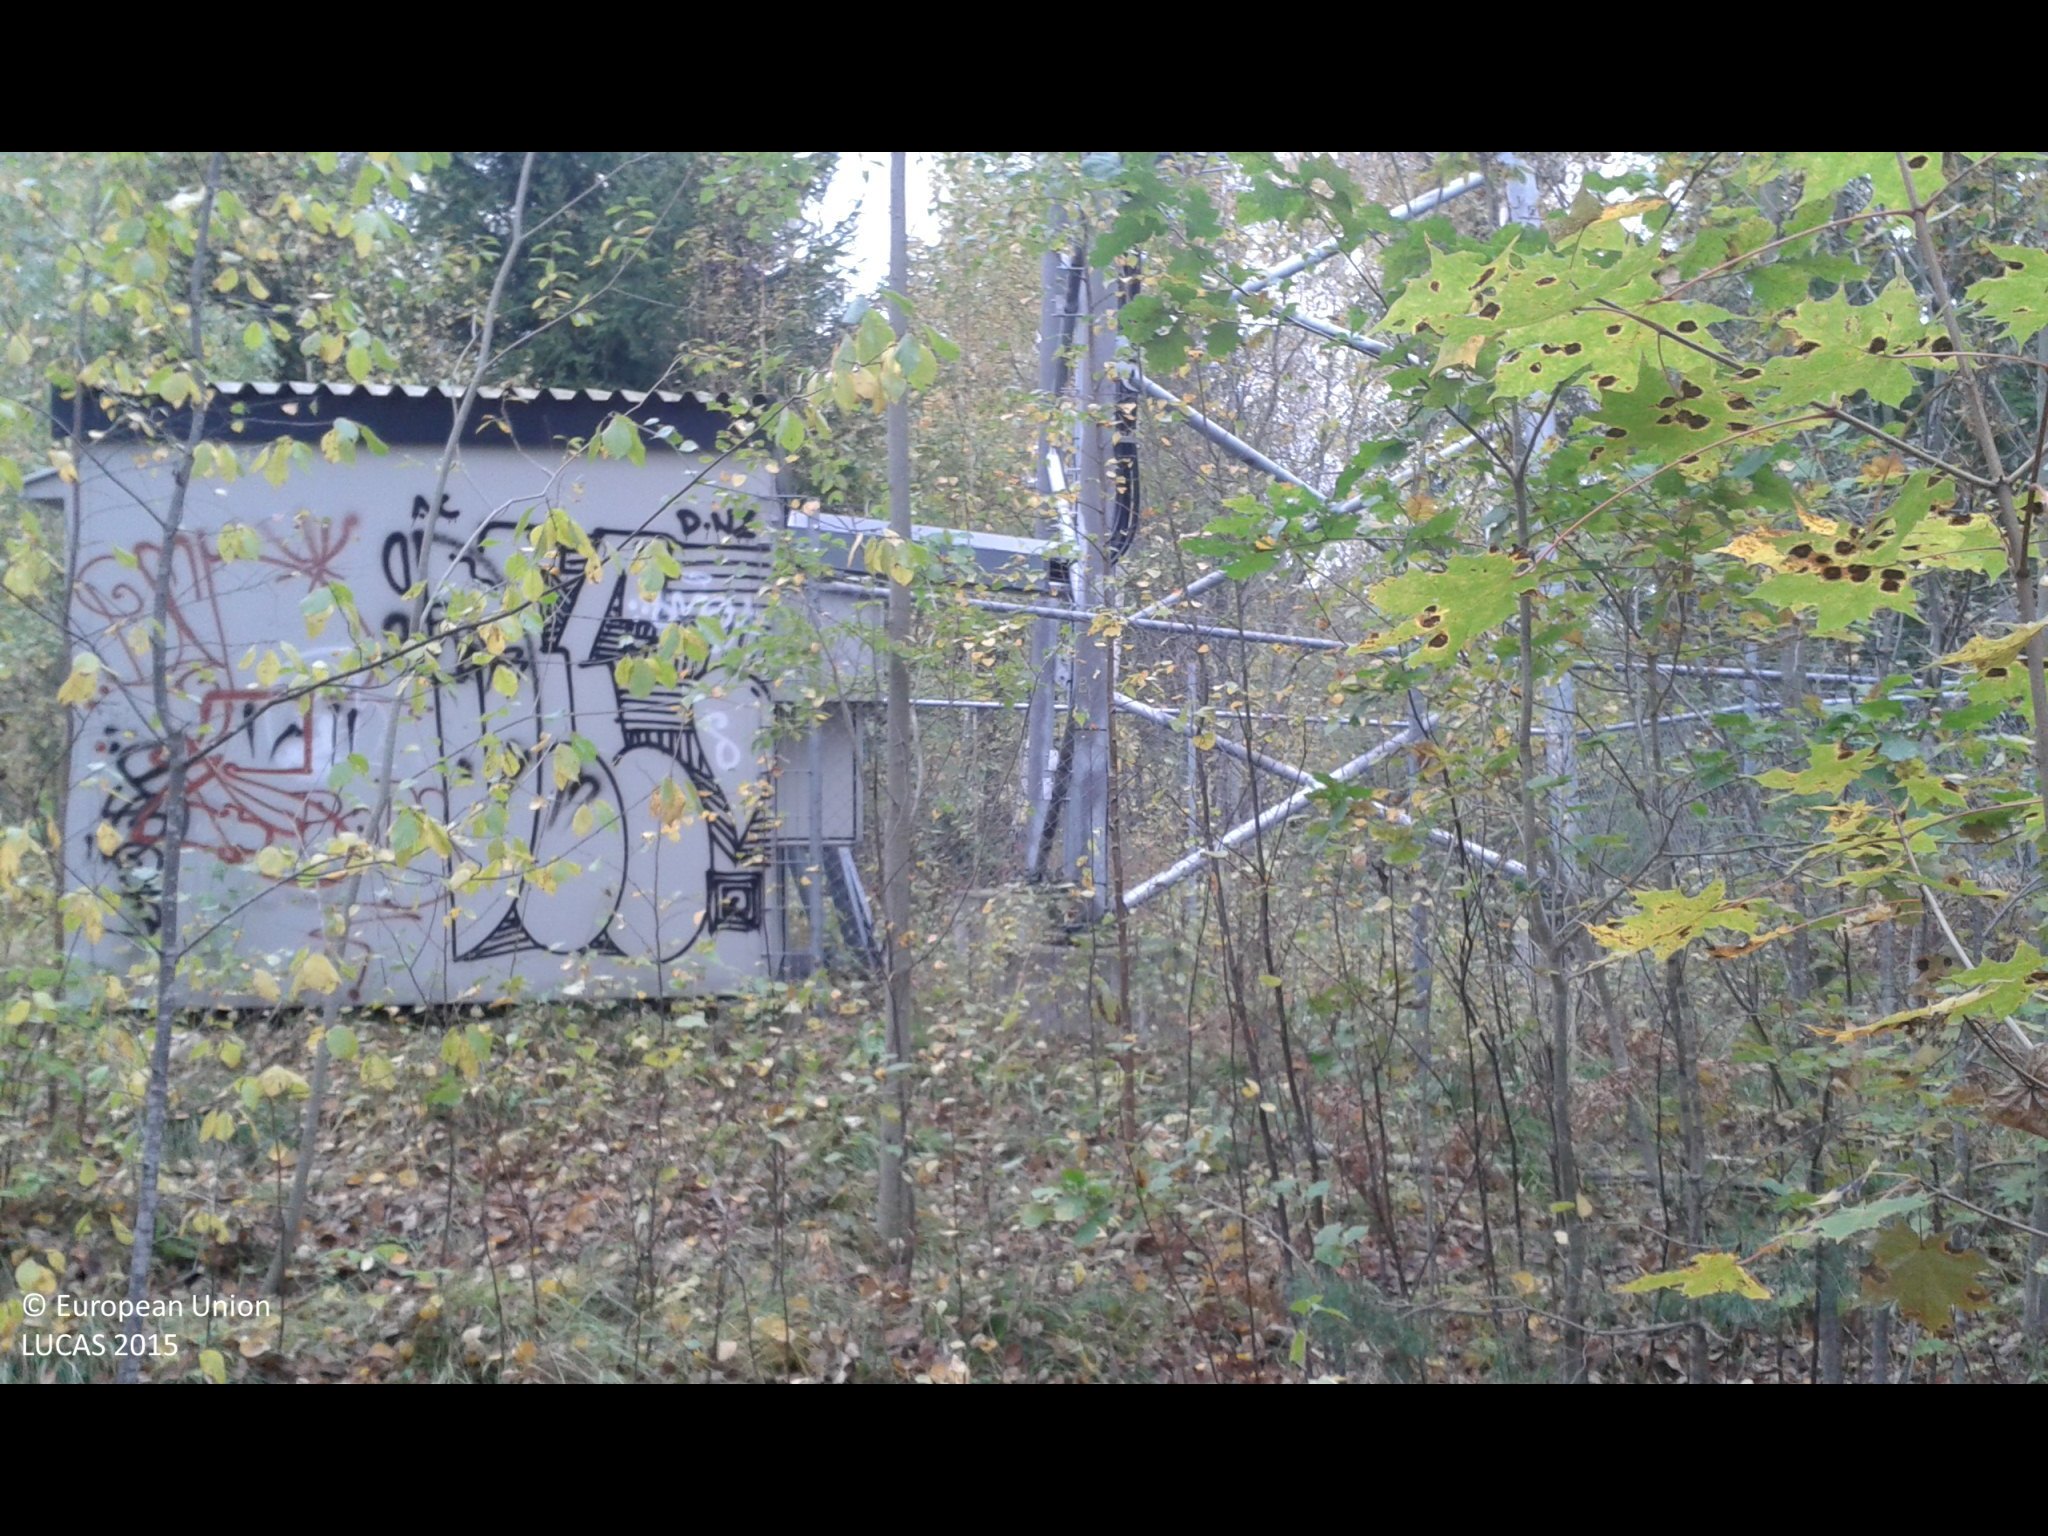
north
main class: Woodland
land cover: Broadleaved woodland
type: hemiboreal forest and nemoral coniferous forest and mixed broadleaved-coniferous forest
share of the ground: 50 - 75 %
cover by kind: broadleaved forest trees 60 %, herbaceous plants 30 %, coniferous forest trees 10 %
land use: Telecommunication
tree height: > 5 m
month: October
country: SE
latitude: 58.7223
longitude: 17.0252
